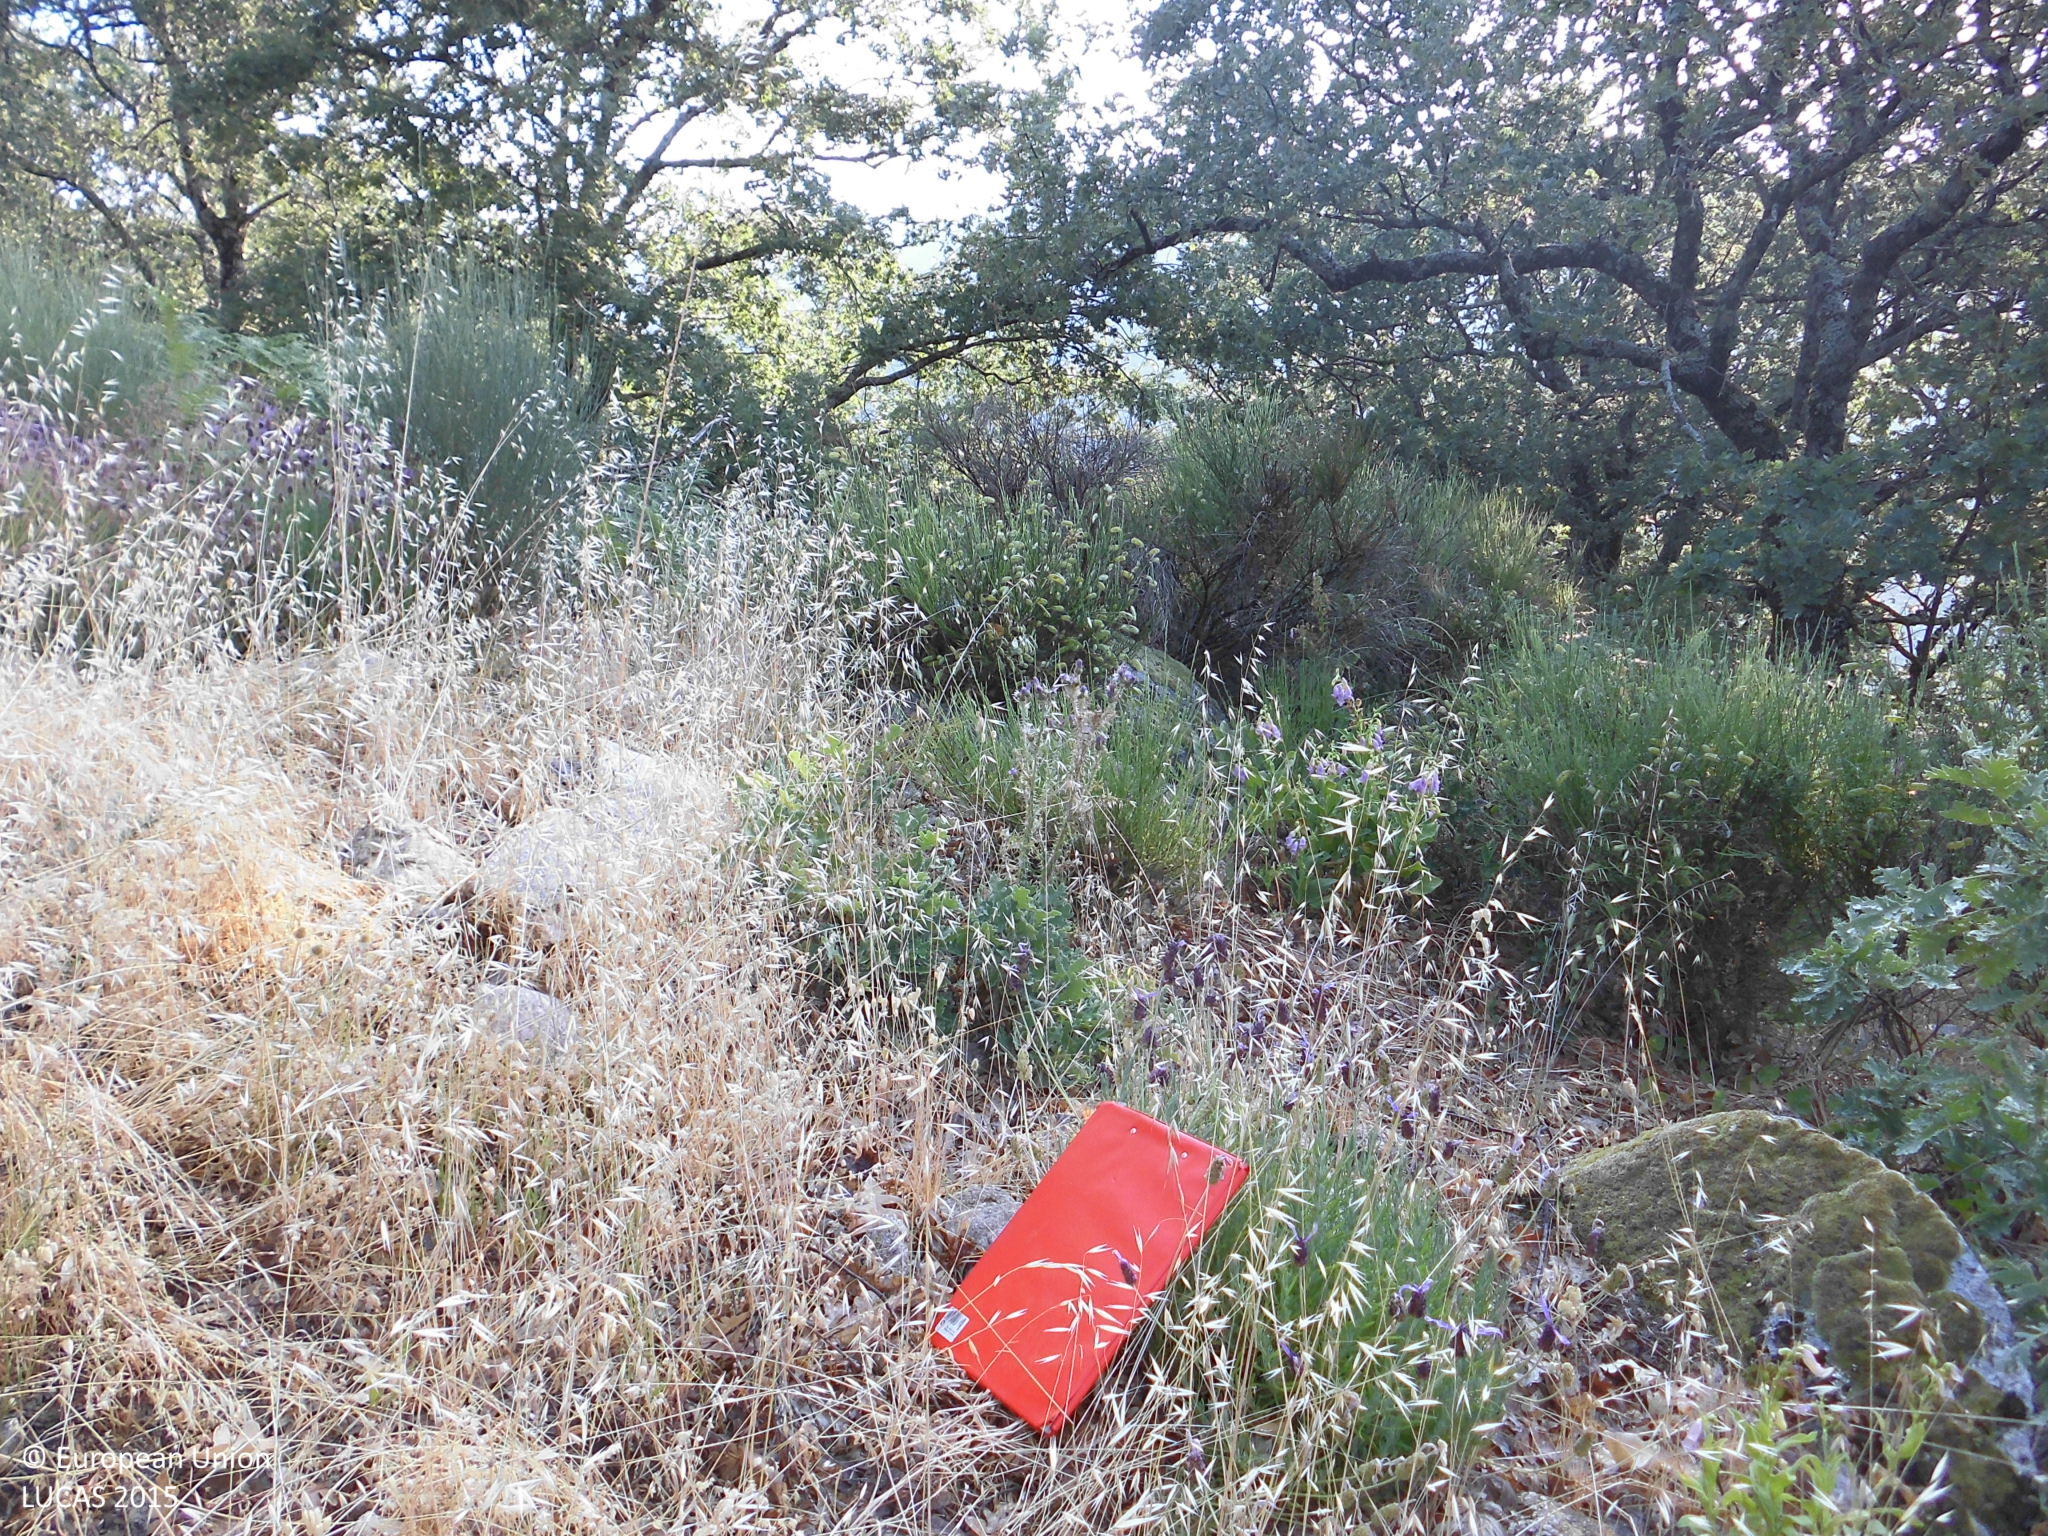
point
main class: Woodland
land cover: Broadleaved woodland
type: thermophilous deciduous forest
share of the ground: 25 - 50 %
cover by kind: broadleaved forest trees 45 %, shrubs 25 %, herbaceous plants 25 %, lichens and mosses 5 %
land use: Forestry
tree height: > 5 m
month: June
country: ES
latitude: 40.1506
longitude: -5.7143
